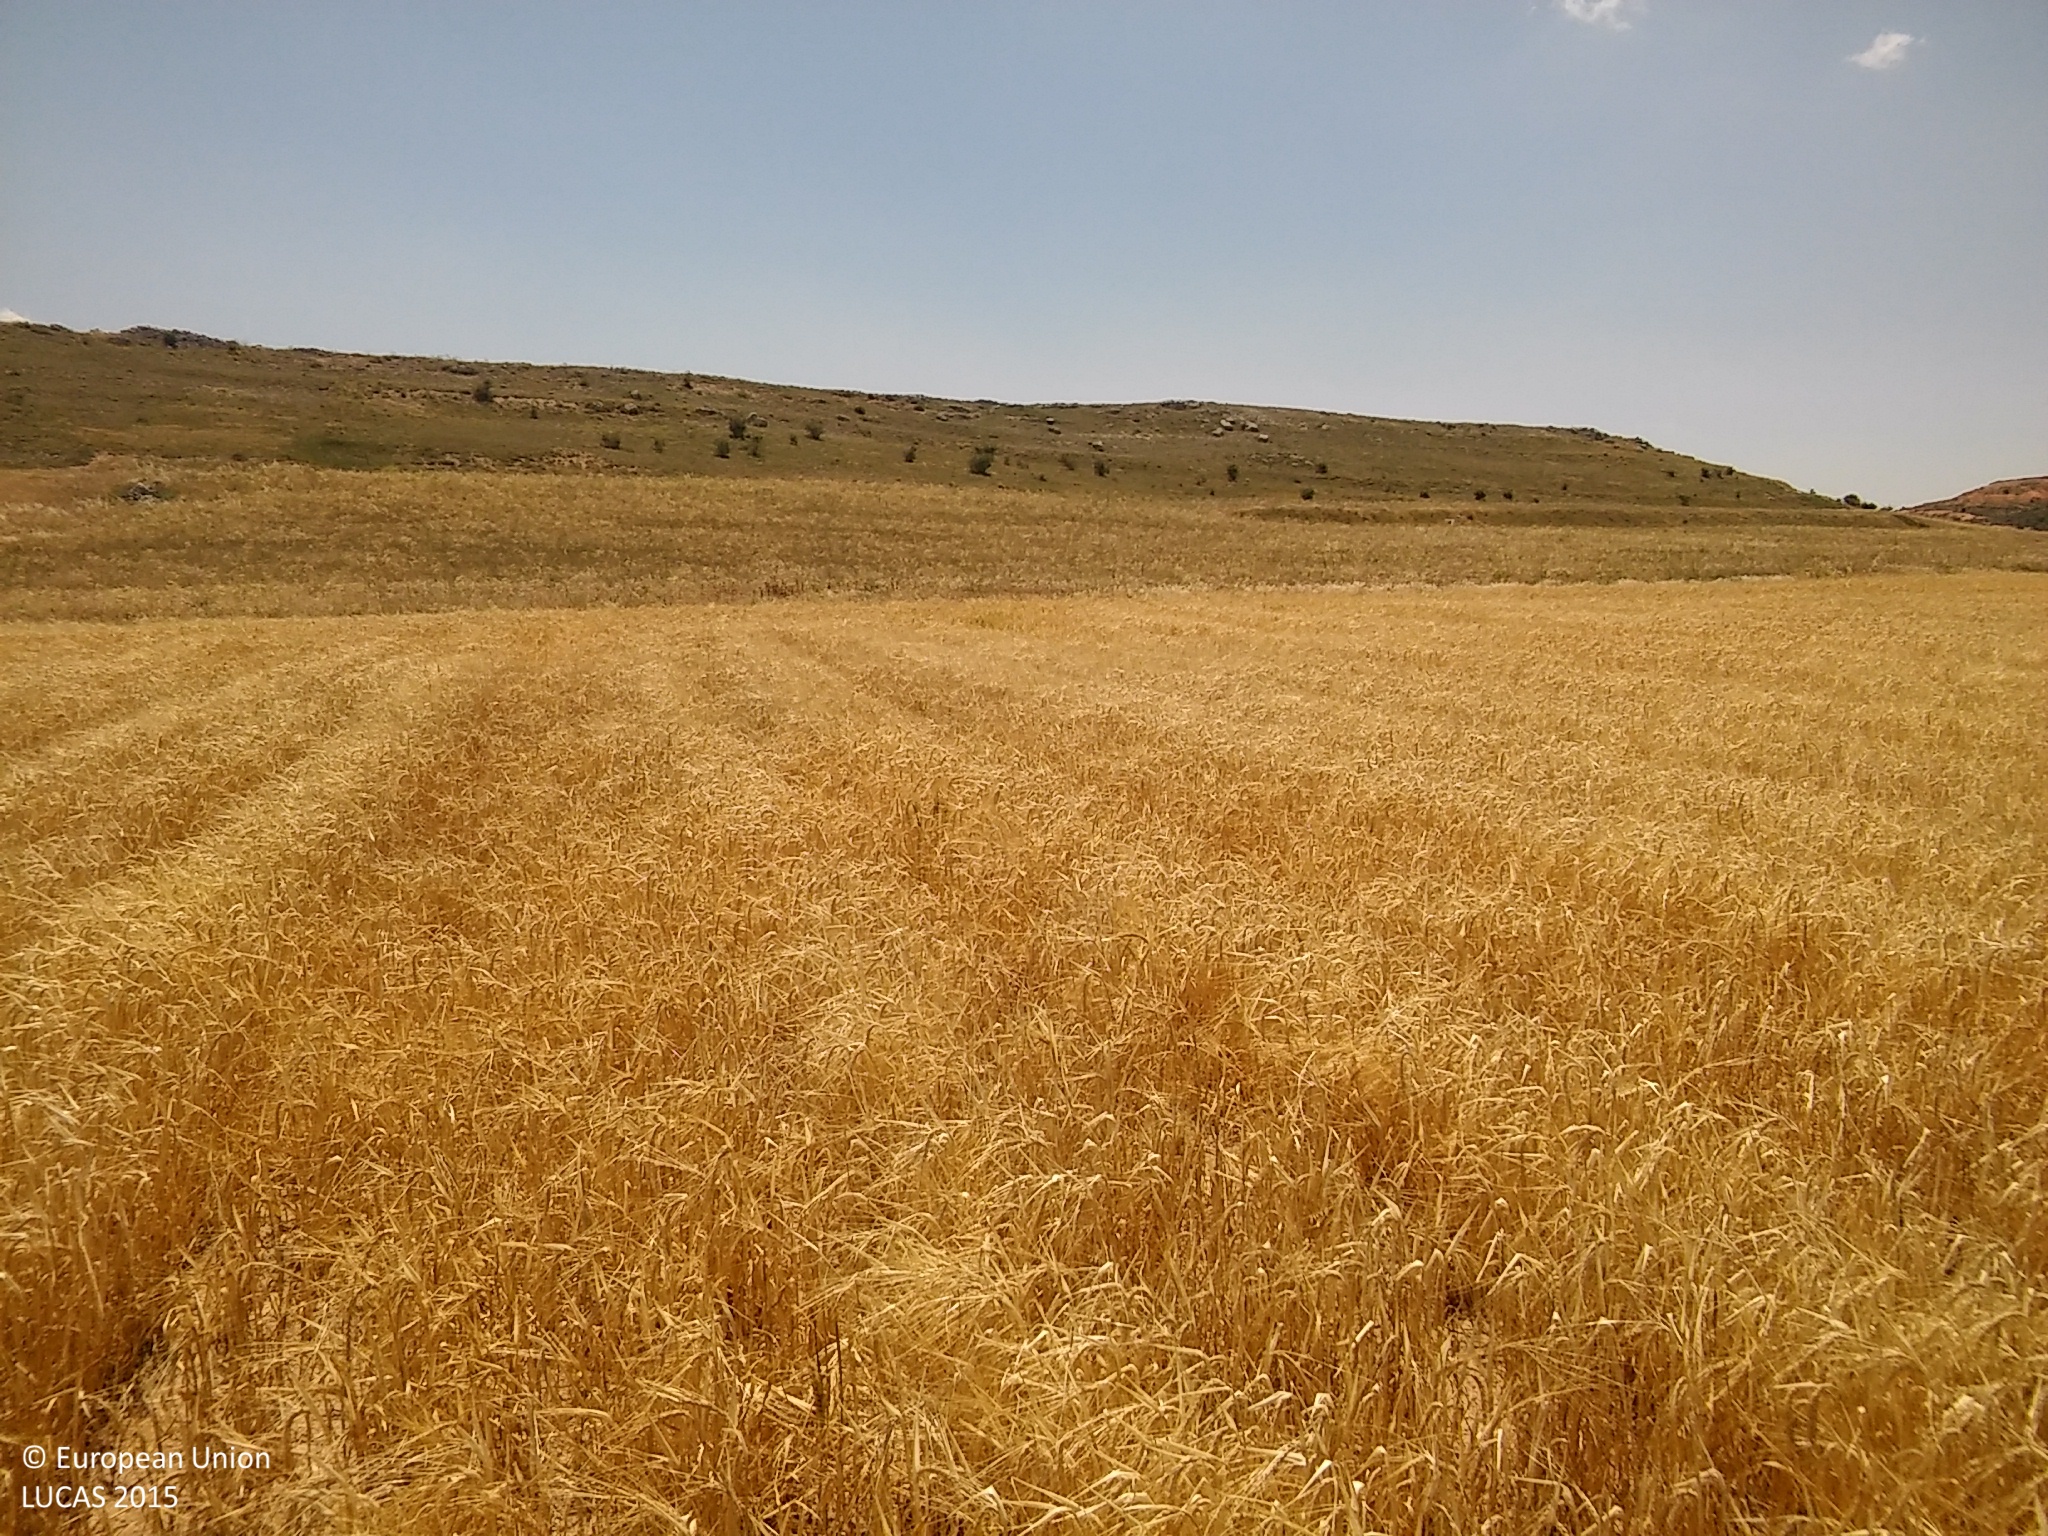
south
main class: Cropland
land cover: Barley
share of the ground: > 75 %
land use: Agriculture (excluding fallow land and kitchen gardens)
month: July
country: ES
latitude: 41.4833
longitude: -3.5459
